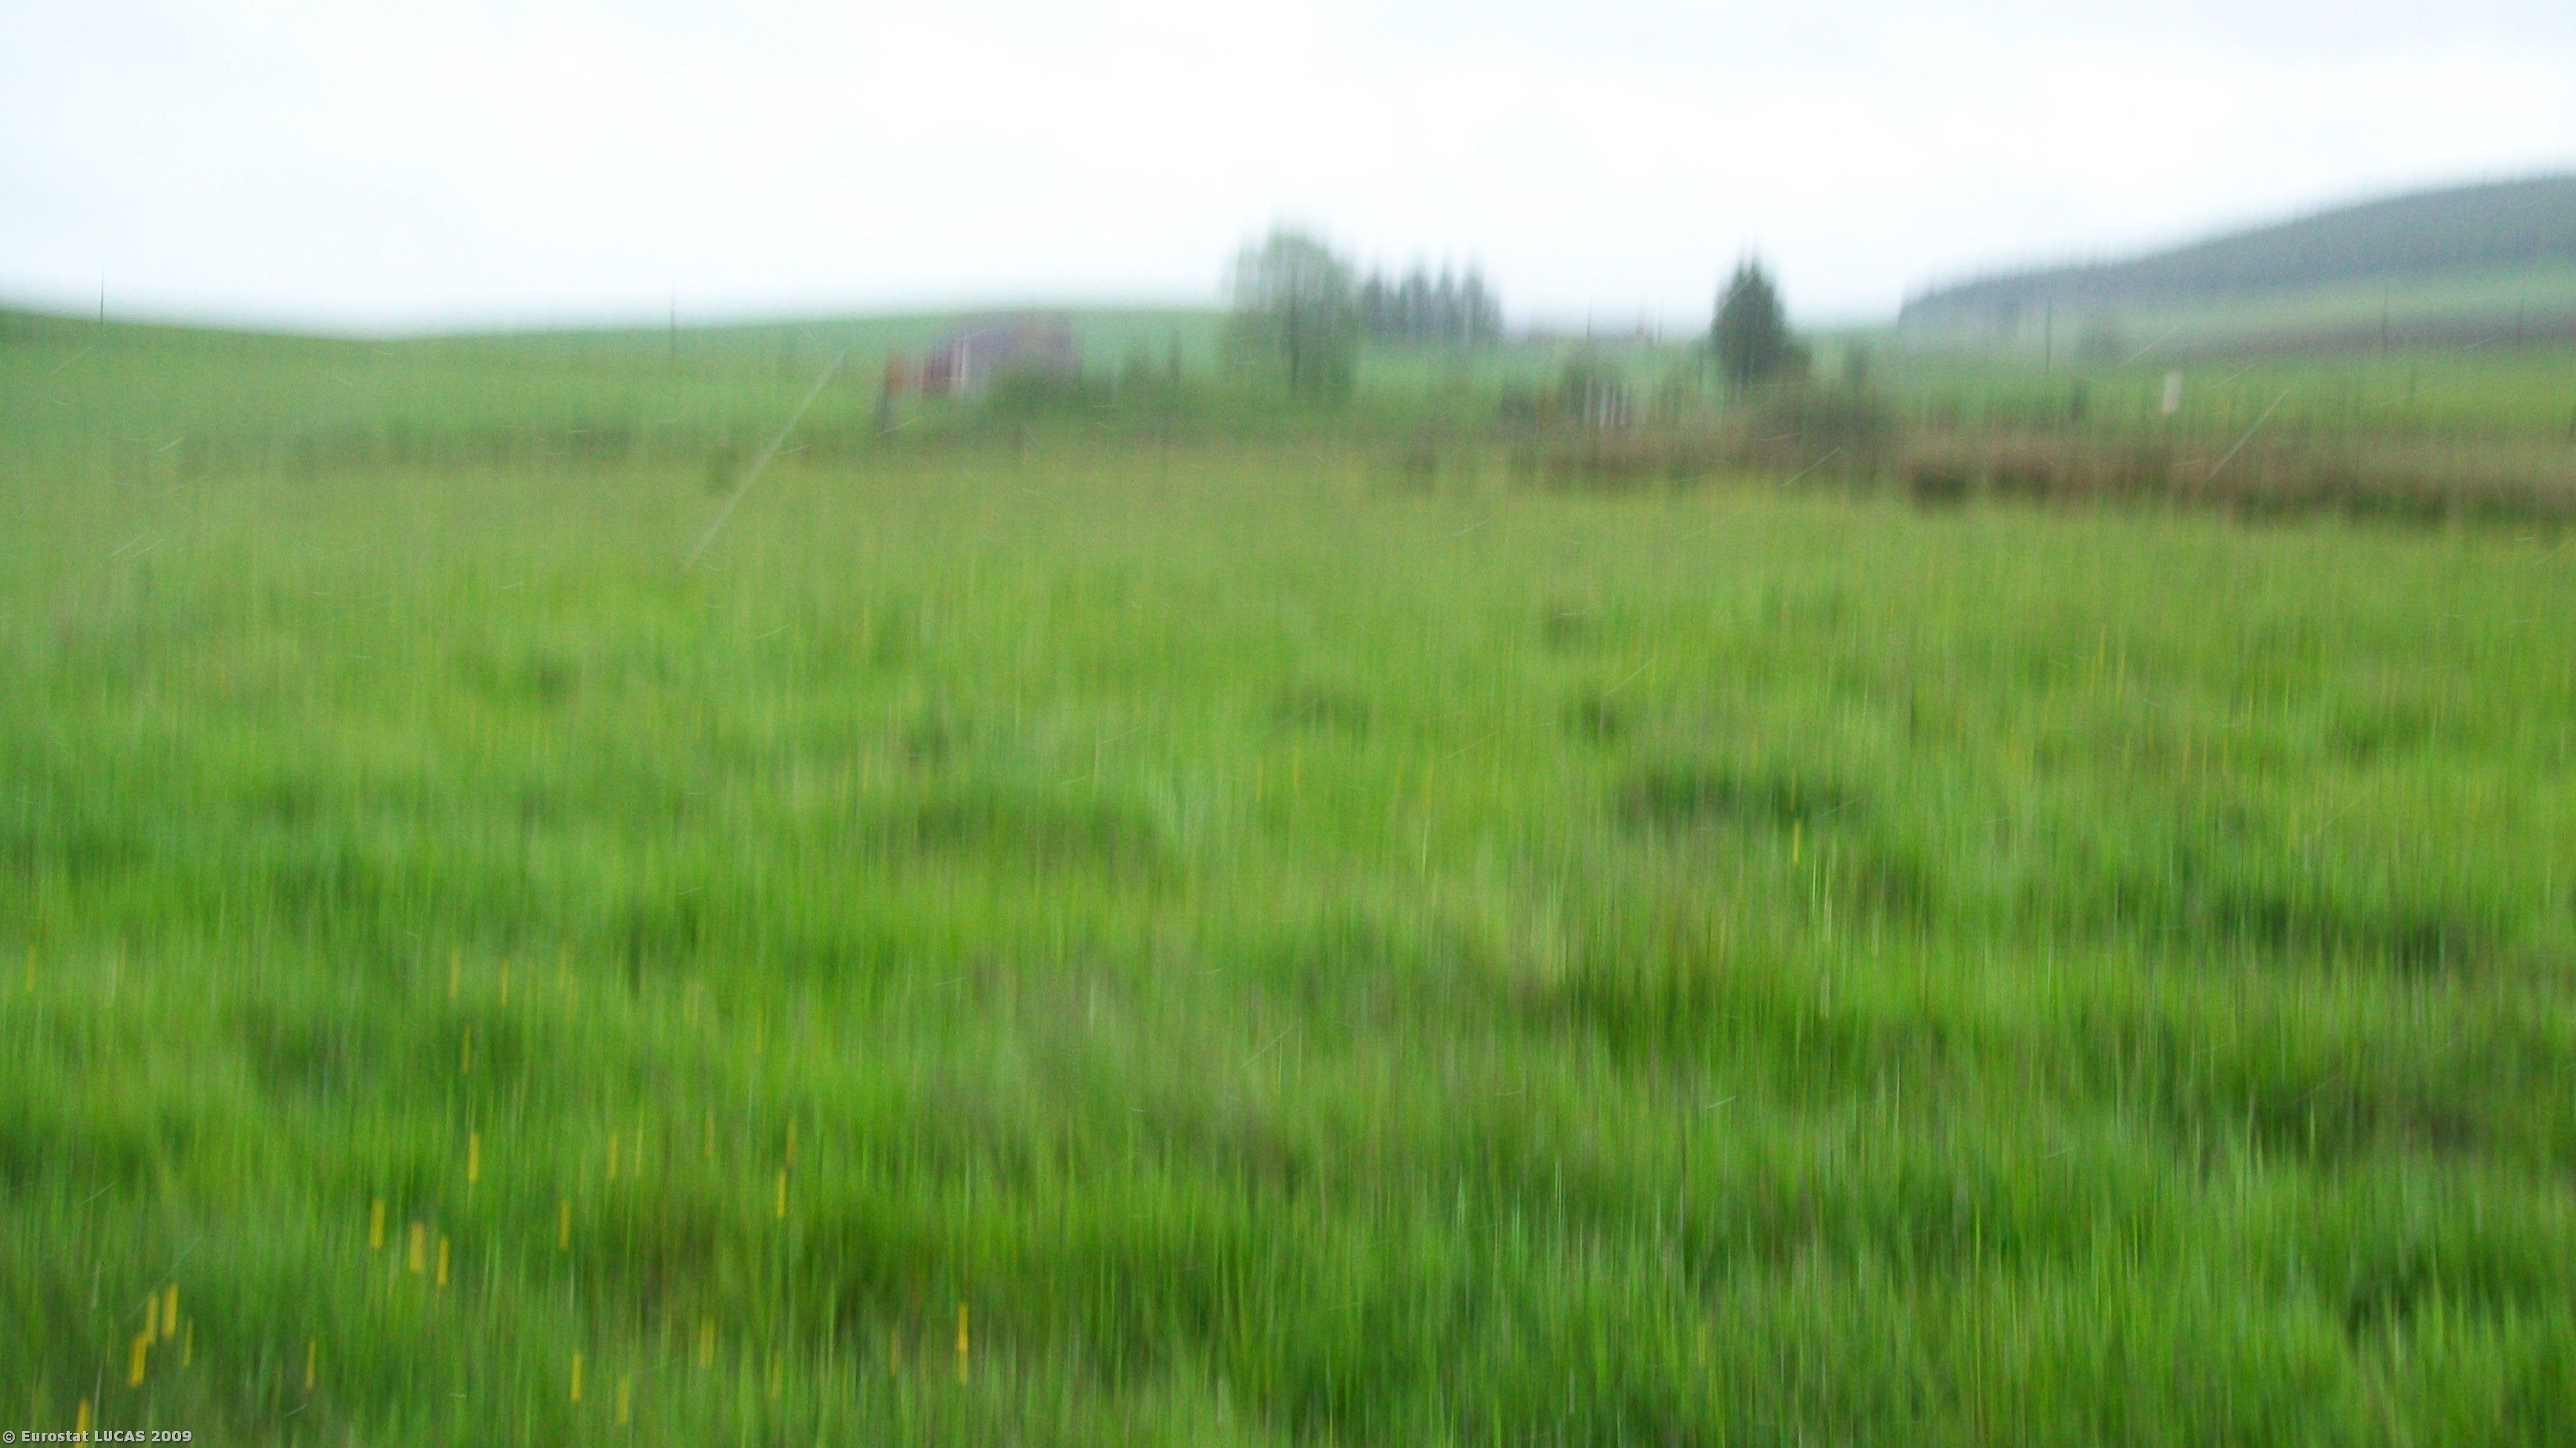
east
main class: Grassland
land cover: Grassland without tree/shrub cover
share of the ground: > 75 %
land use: Agriculture (excluding fallow land and kitchen gardens)
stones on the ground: 10 - 25 %
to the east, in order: Grassland without tree/shrub cover; Fences; Inland marshes; Fences; Grassland without tree/shrub cover; Rivers and streams; Grass margins; Dry stone walls; Grassland without tree/shrub cover; Shrubland without tree cover
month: June
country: GB
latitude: 57.5887
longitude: -2.5828
